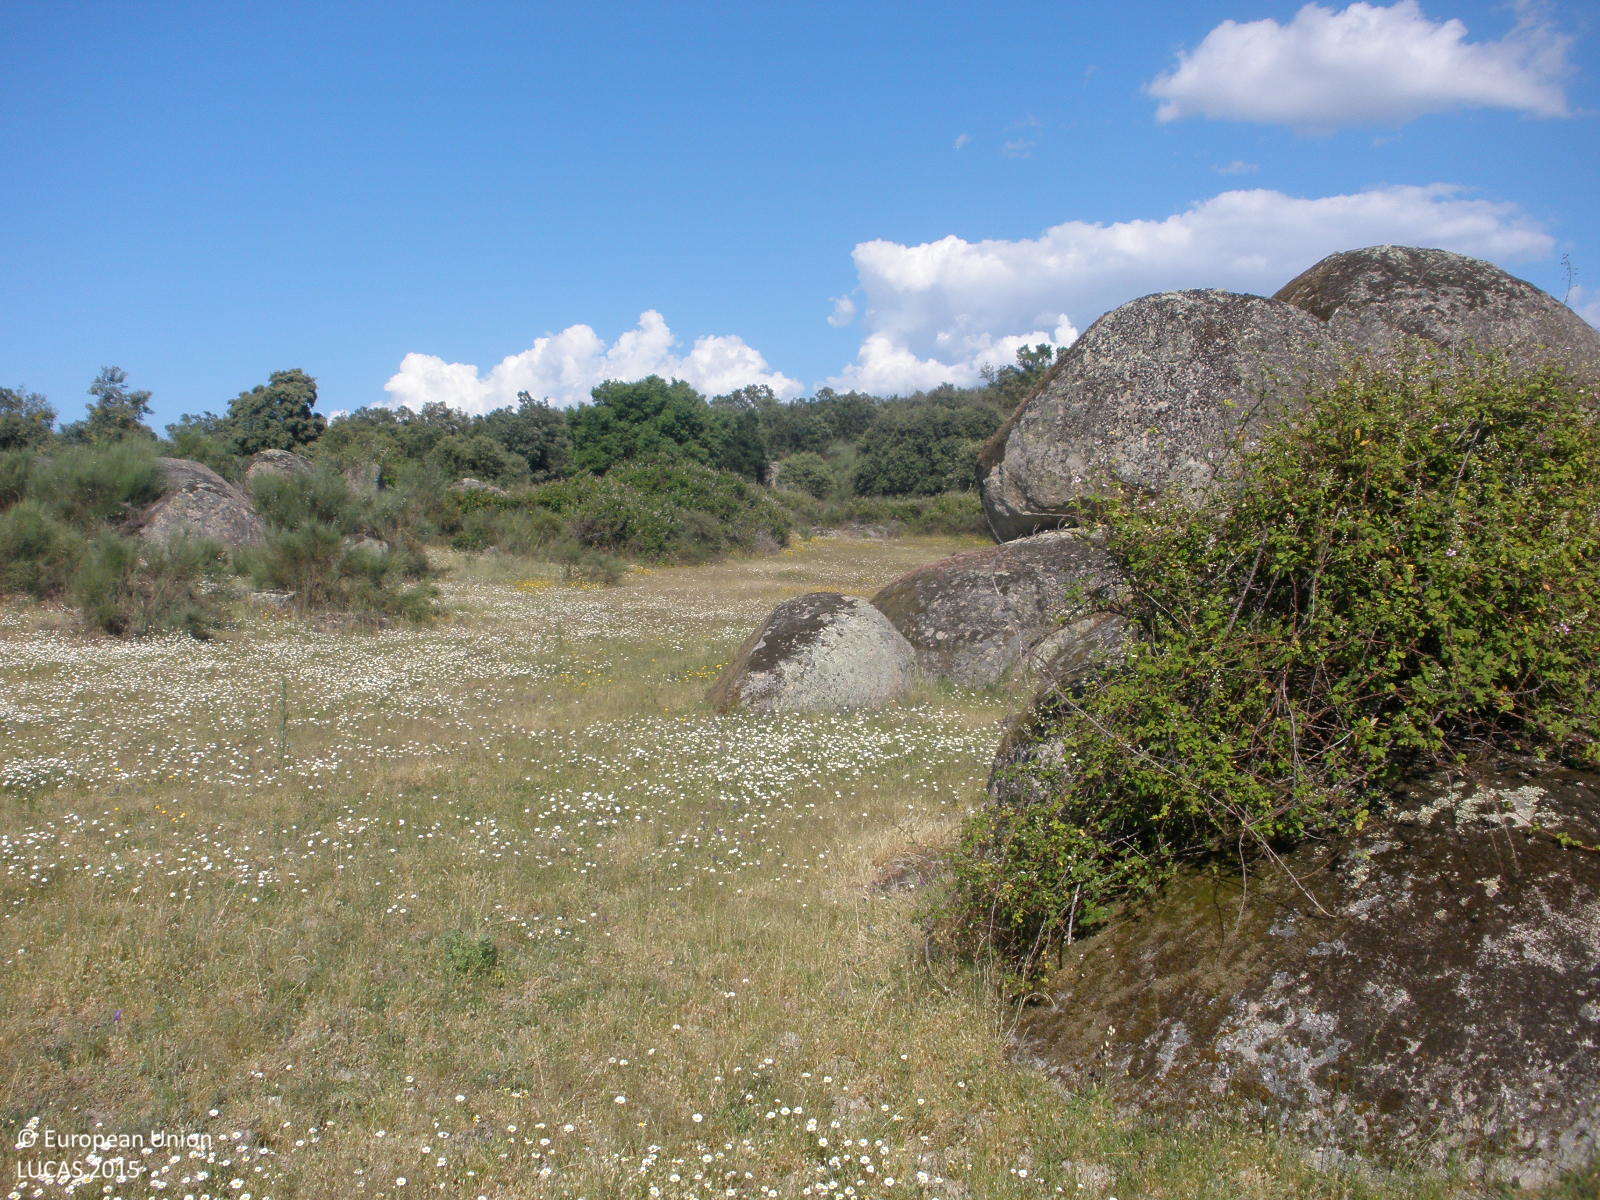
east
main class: Grassland
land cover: Grassland without tree/shrub cover
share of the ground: > 75 %
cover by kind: herbaceous plants 90 %, consolidated bare surface 10 %
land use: Agriculture (excluding fallow land and kitchen gardens)
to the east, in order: Grassland without tree/shrub cover; Broadleaved woodland; Dry stone walls; Broadleaved woodland
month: May
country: ES
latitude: 40.1555
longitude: -6.2425
